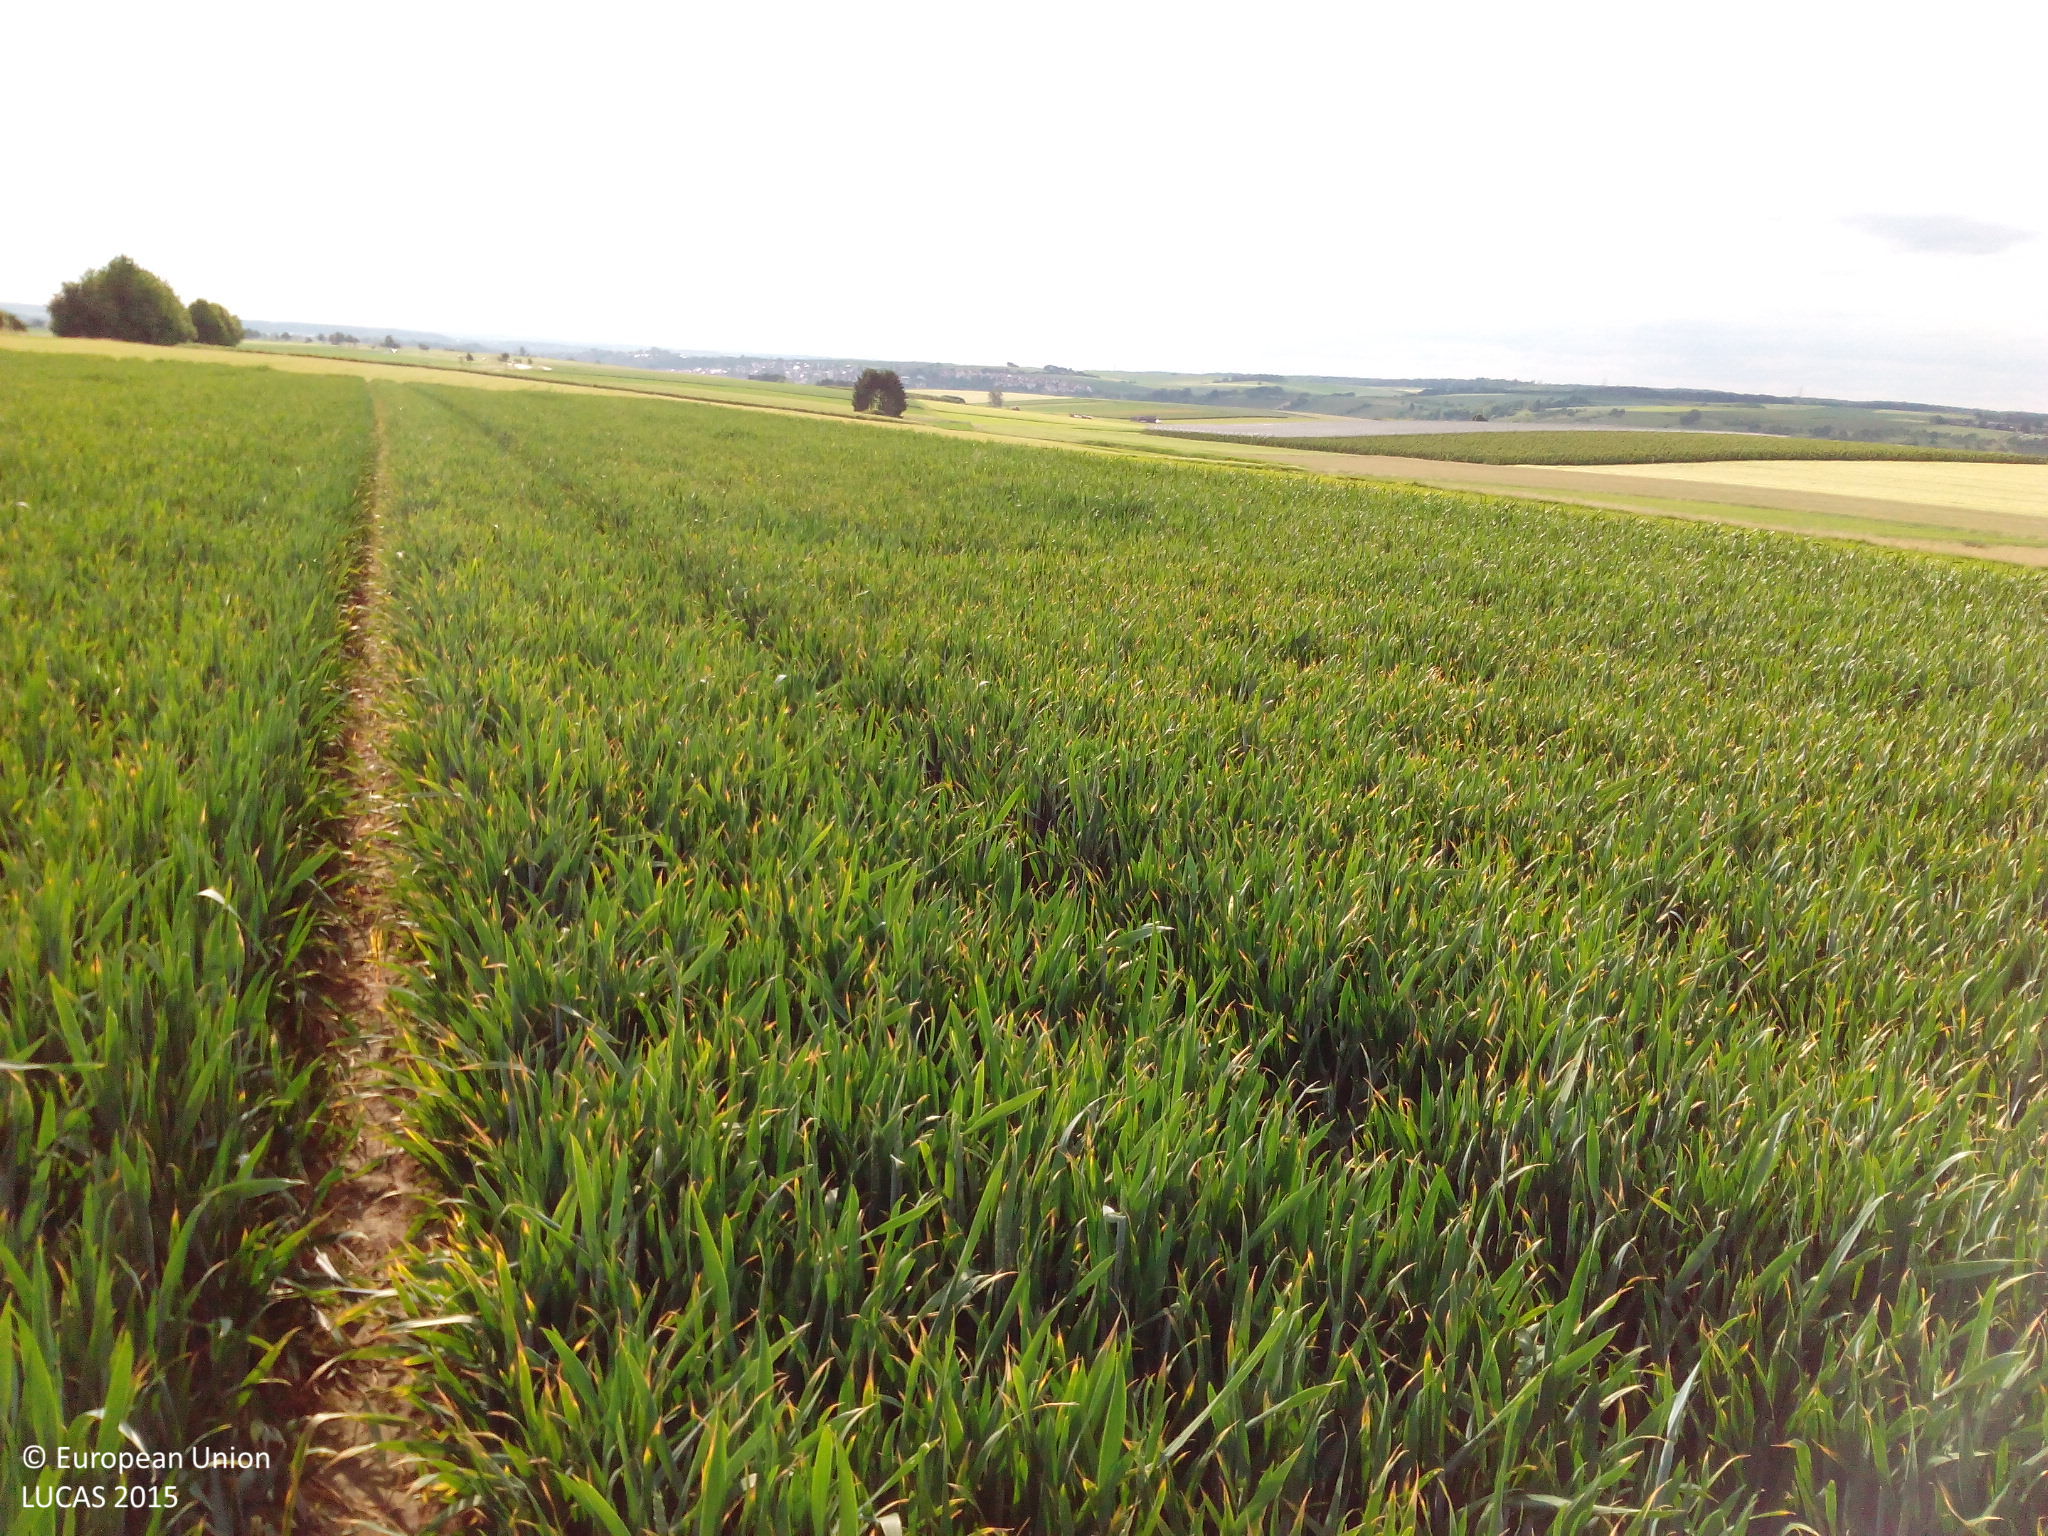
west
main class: Cropland
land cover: Common wheat
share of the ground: > 75 %
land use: Agriculture (excluding fallow land and kitchen gardens)
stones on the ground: < 10 %
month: May
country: DE
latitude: 49.2295
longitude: 9.4098
